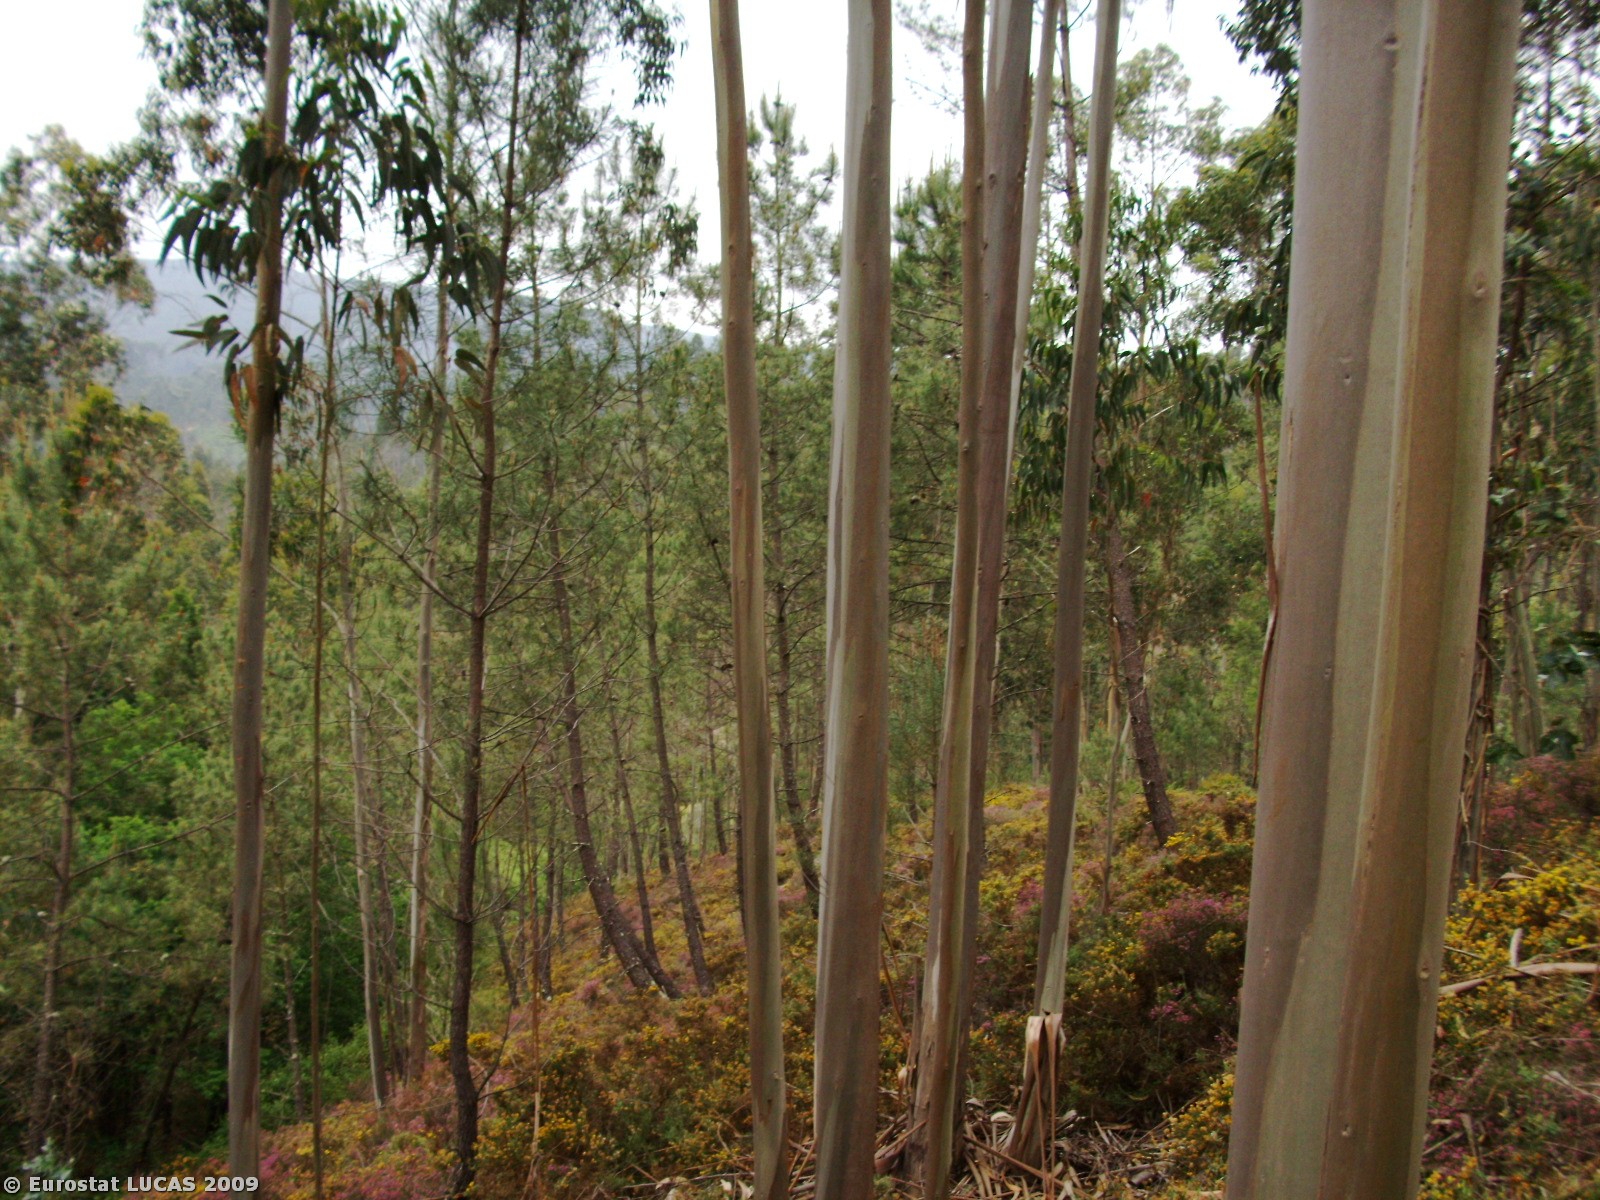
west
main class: Woodland
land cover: Broadleaved woodland
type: plantations and self-sown exotic forest
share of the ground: > 75 %
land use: Forestry
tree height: > 5 m
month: May
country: PT
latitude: 40.3558
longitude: -8.3220
